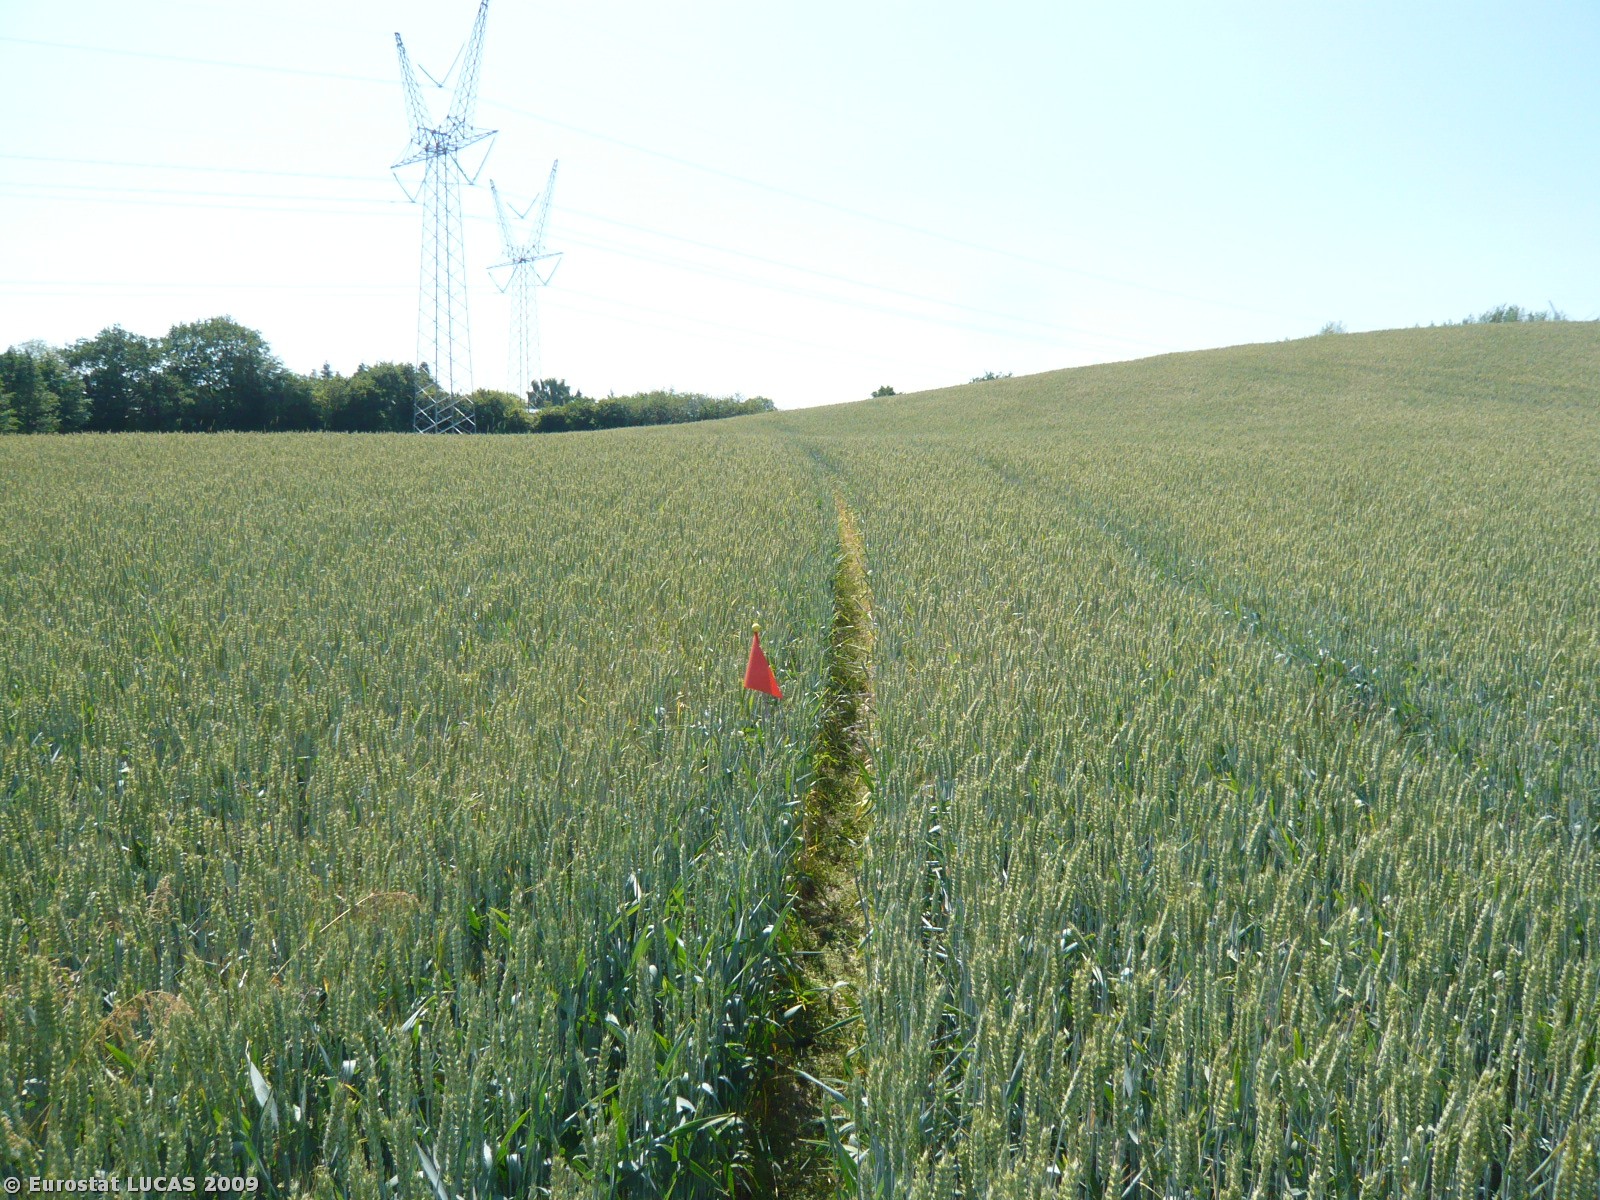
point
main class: Cropland
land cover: Common wheat
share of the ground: > 75 %
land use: Agriculture (excluding fallow land and kitchen gardens)
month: July
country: DK
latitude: 55.3968
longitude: 10.1420
